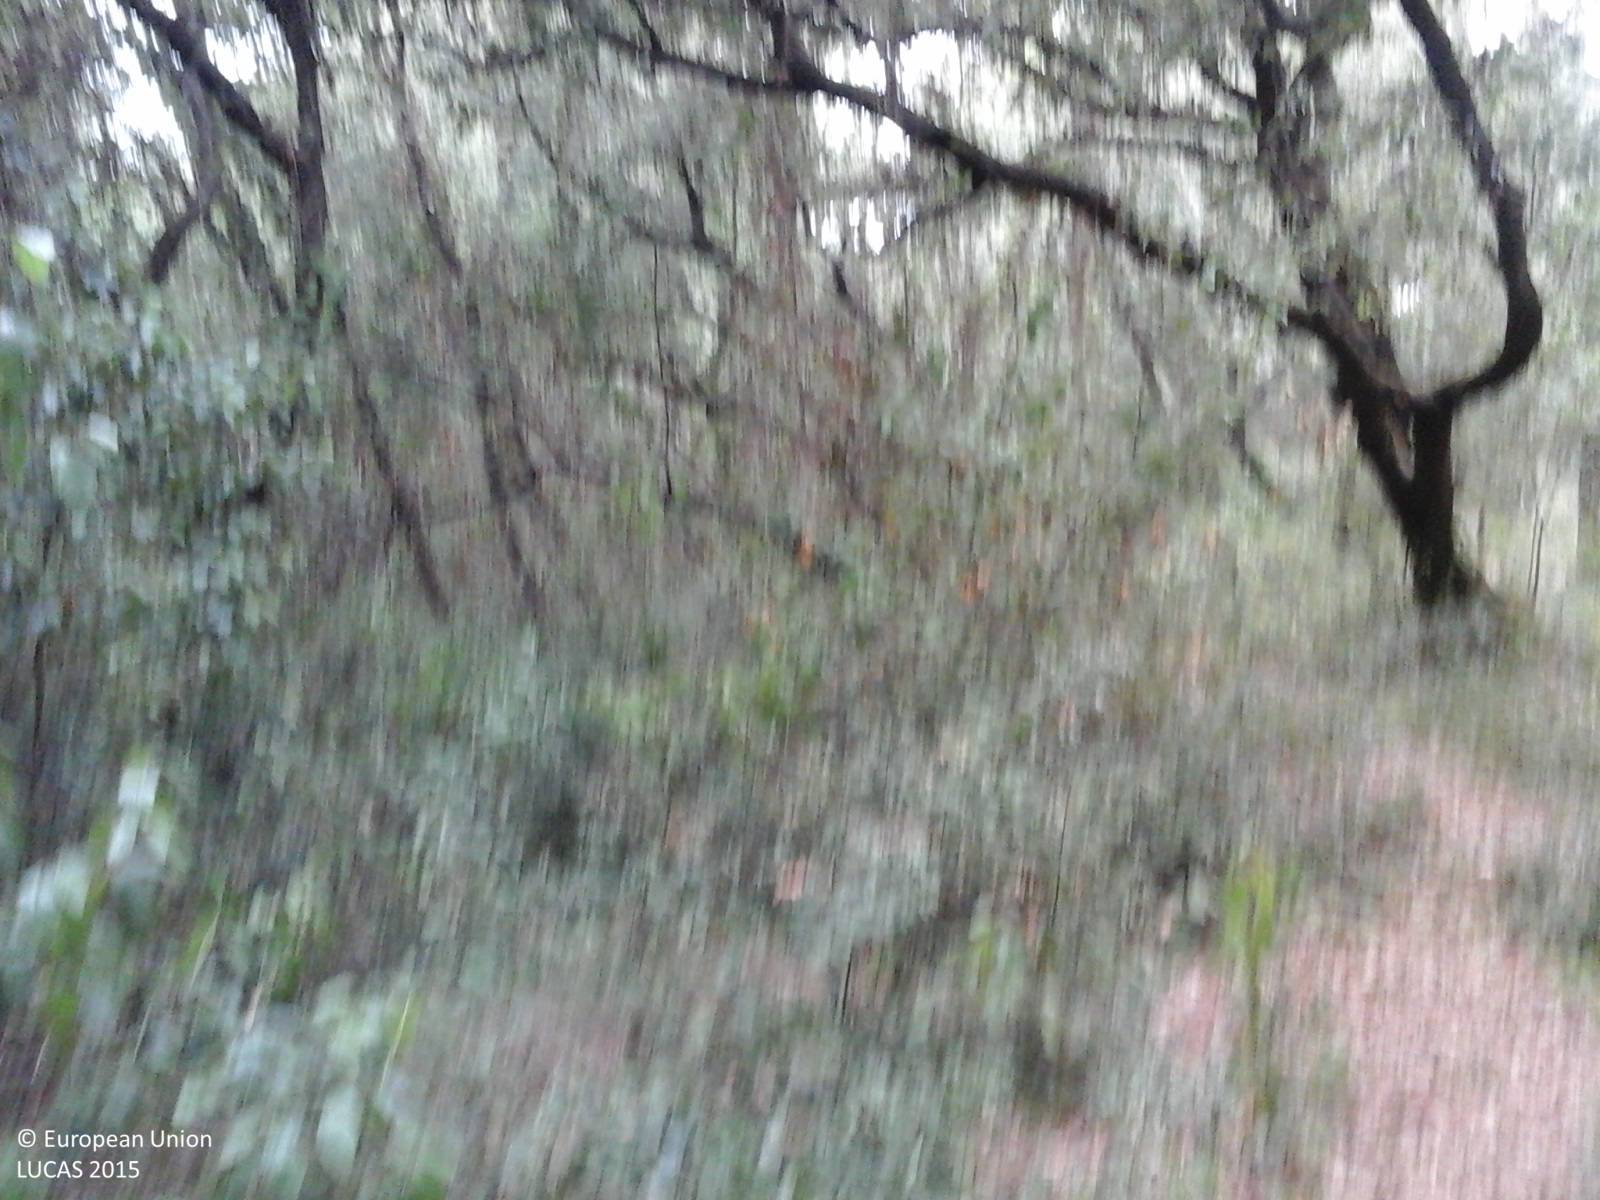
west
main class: Woodland
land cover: Pine dominated mixed woodland
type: coniferous forest of the mediterranean region
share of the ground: > 75 %
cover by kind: coniferous forest trees 65 %, broadleaved forest trees 25 %, shrubs 10 %
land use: Amenities, museums, leisure
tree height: > 5 m
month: July
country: IT
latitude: 41.7239
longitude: 12.3110
